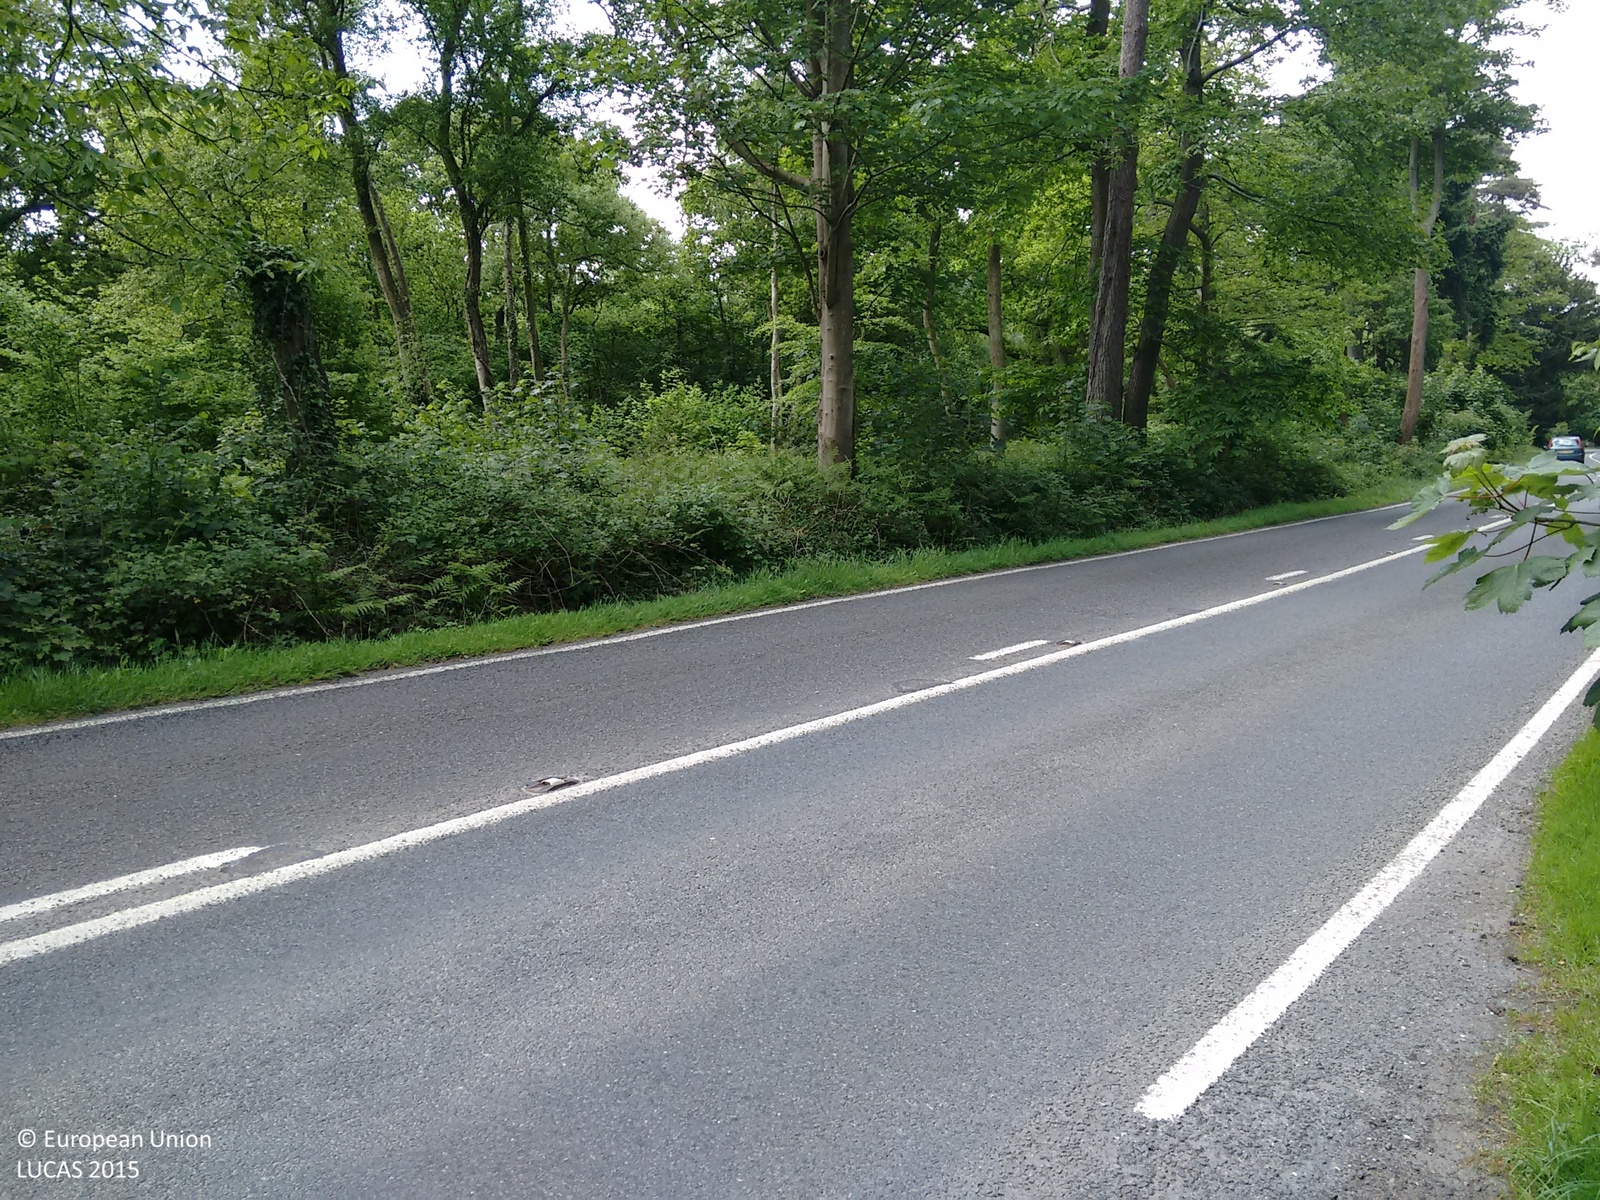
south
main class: Woodland
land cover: Broadleaved woodland
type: mesophytic deciduous forest
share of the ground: > 75 %
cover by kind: broadleaved forest trees 90 %, coniferous forest trees 10 %
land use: Forestry
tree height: > 5 m
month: May
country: GB
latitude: 50.8718
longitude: -0.9430
